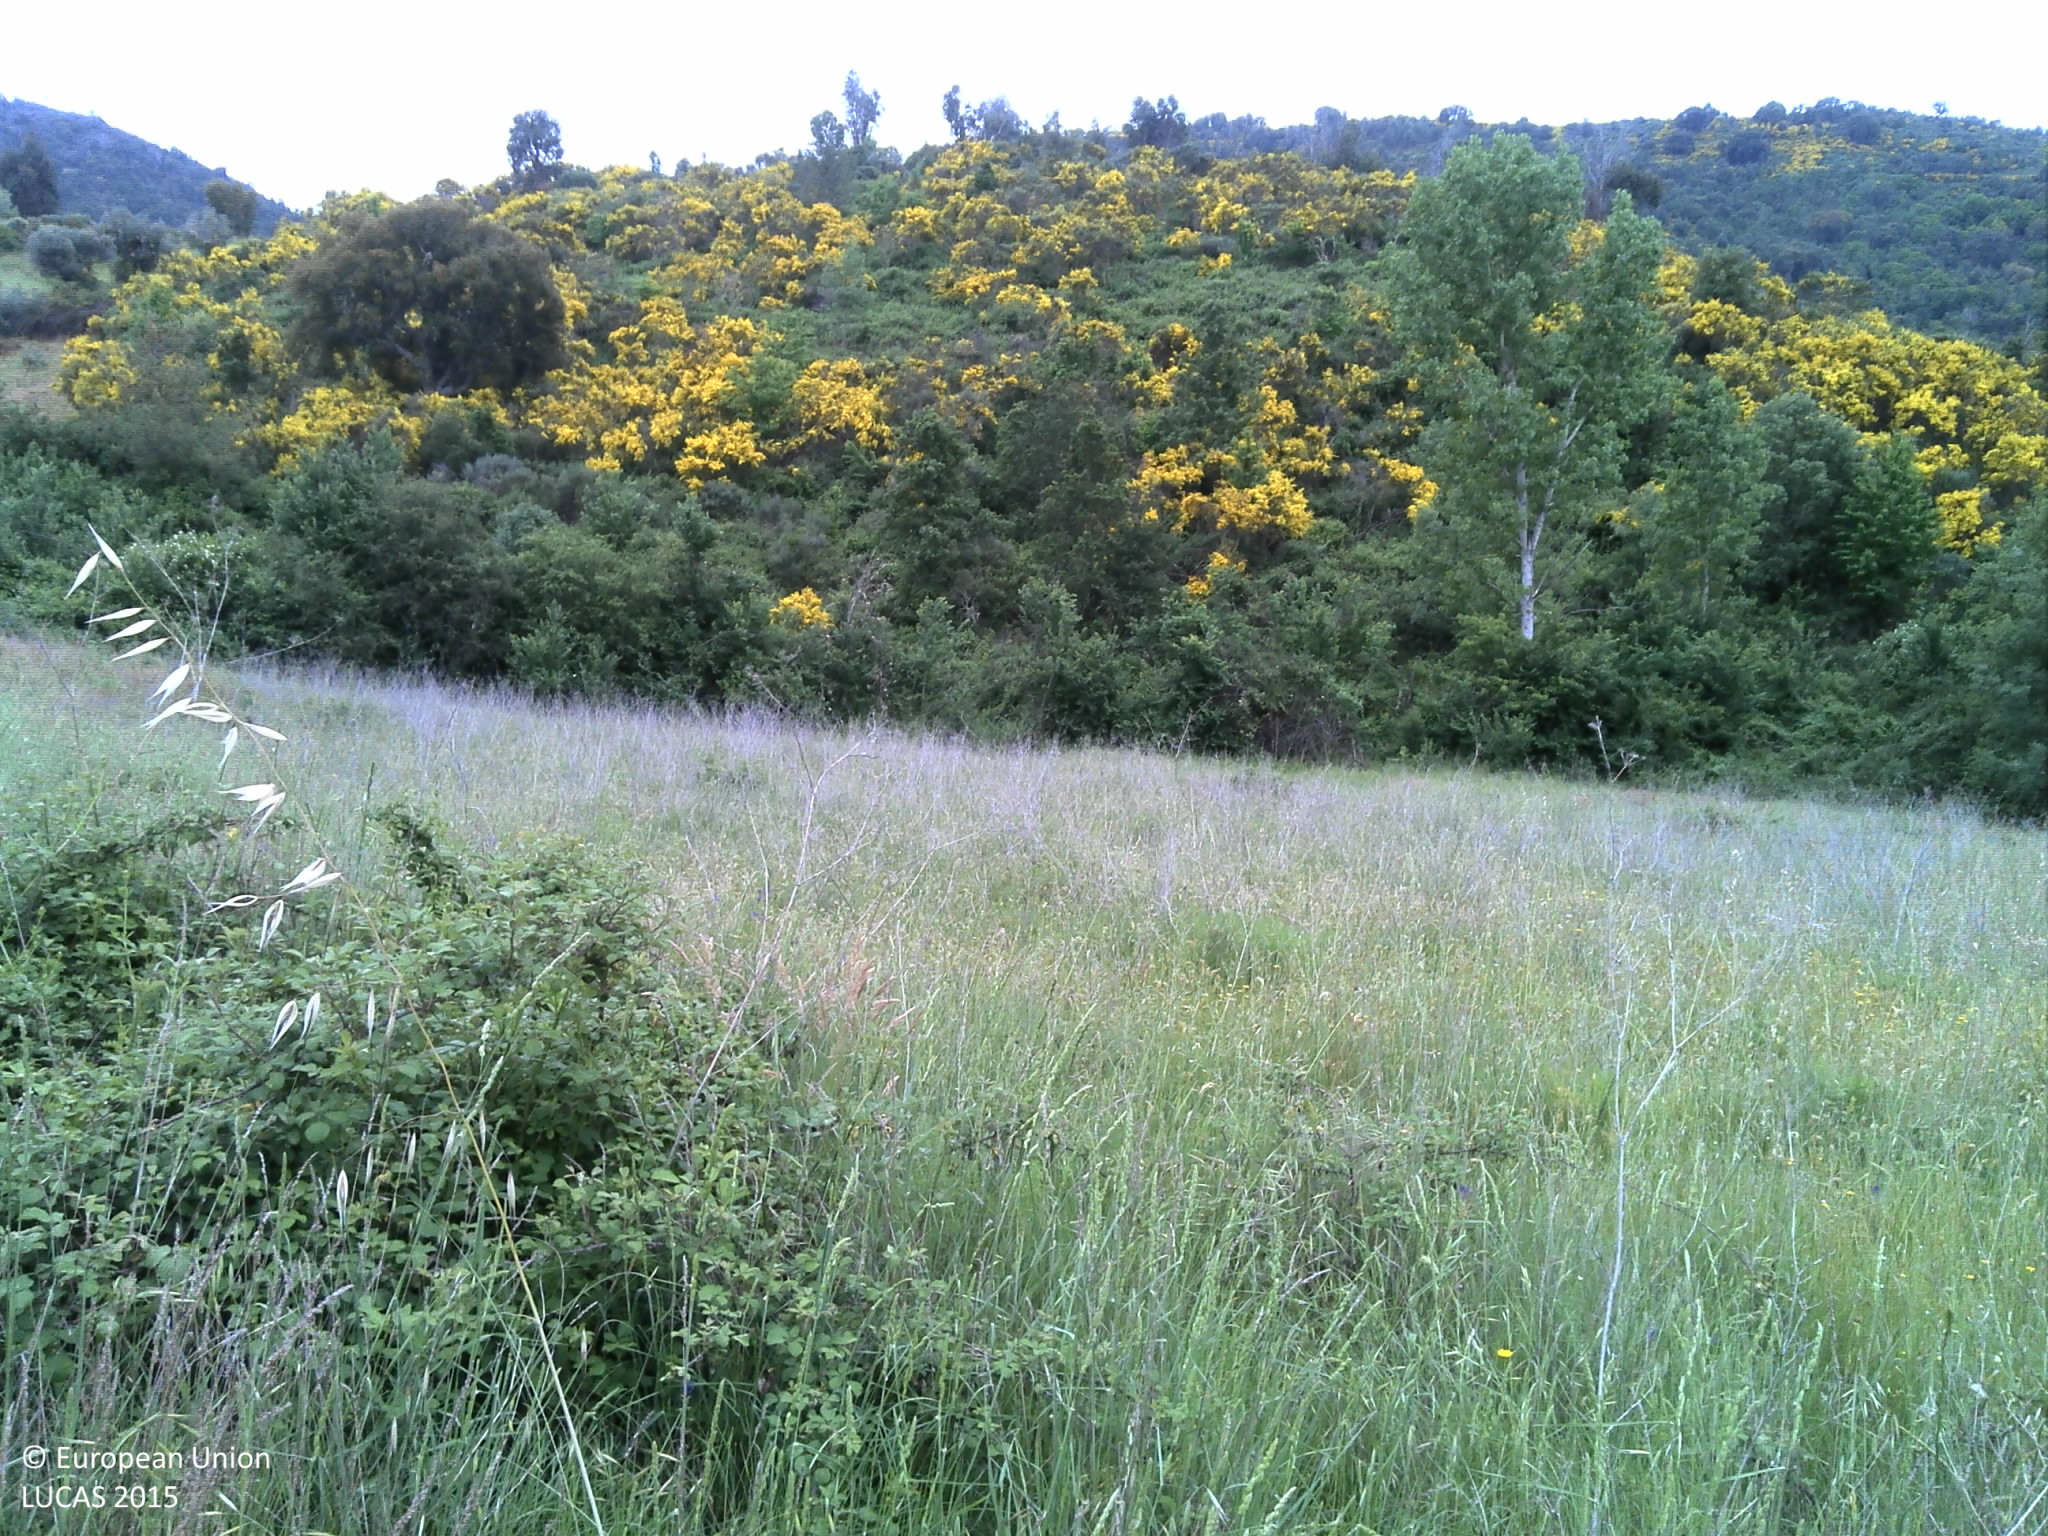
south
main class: Grassland
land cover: Grassland with sparse tree/shrub cover
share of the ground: > 75 %
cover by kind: herbaceous plants 90 %, broadleaved forest trees 5 %, unconsolidated bare surface 5 %
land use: Agriculture (excluding fallow land and kitchen gardens)
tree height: > 5 m
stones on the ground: 10 - 25 %
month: May
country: PT
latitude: 41.6367
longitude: -7.0567
